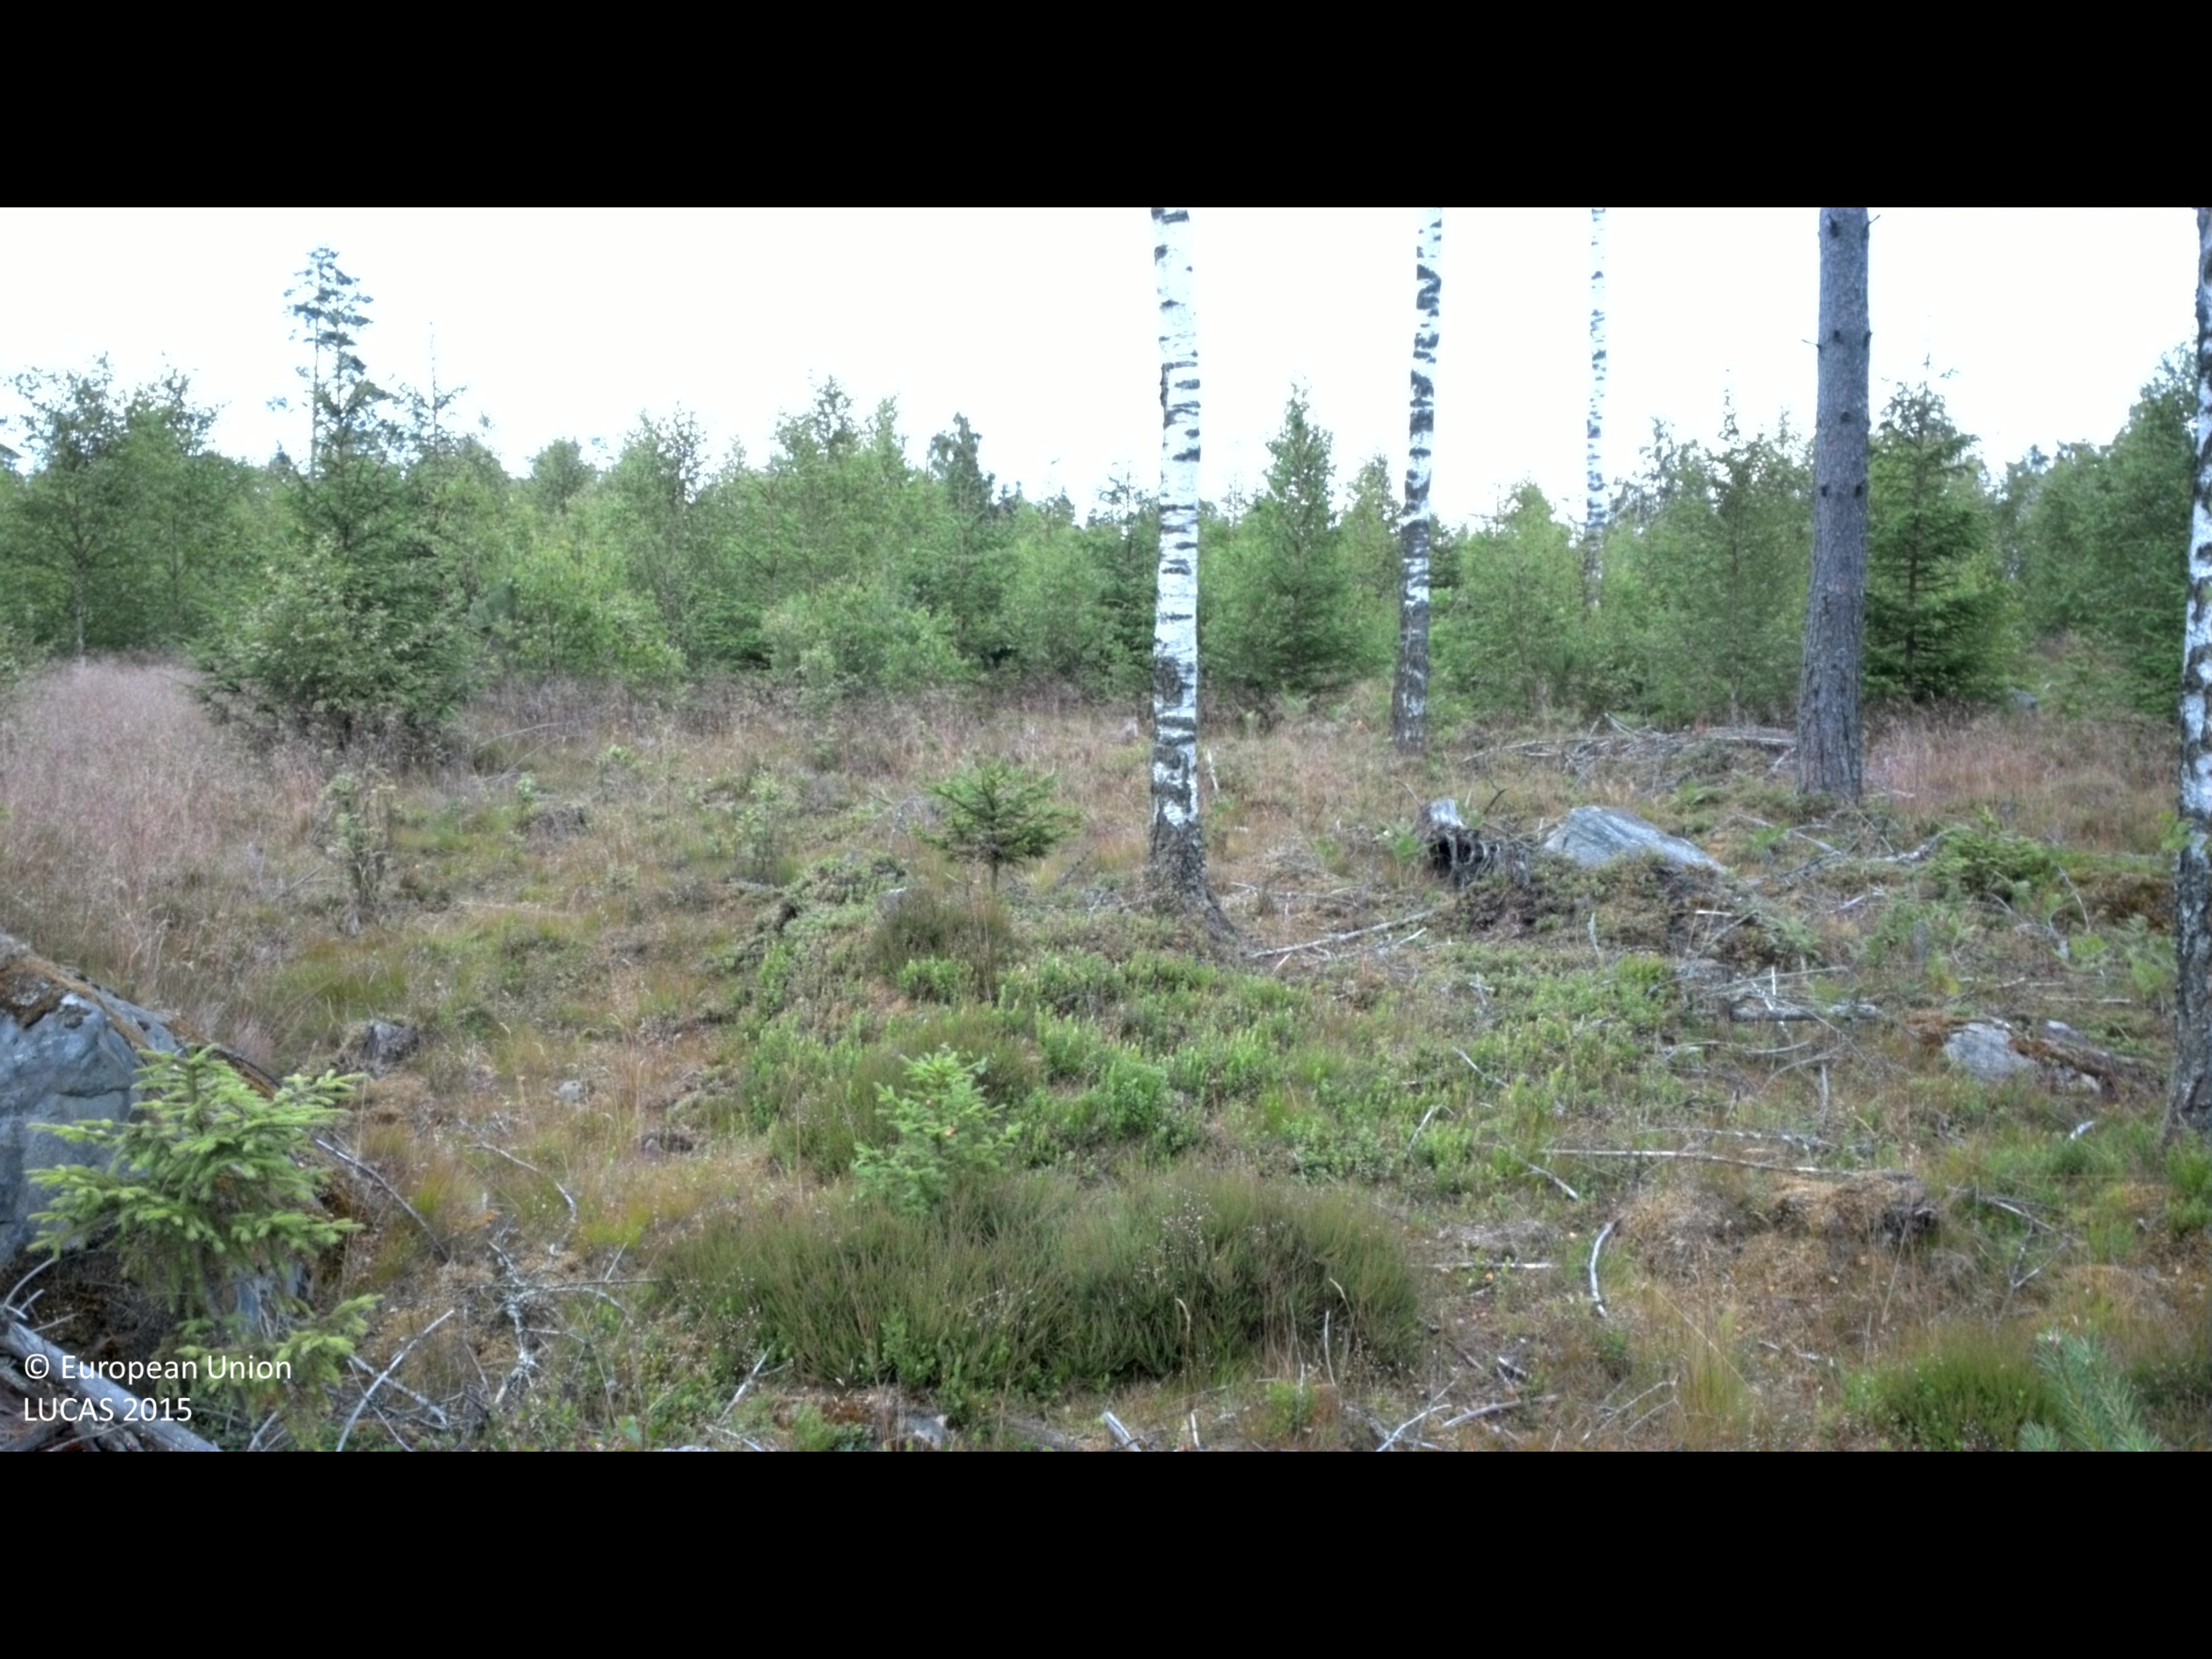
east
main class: Woodland
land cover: Broadleaved woodland
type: boreal forest
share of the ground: 25 - 50 %
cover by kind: broadleaved forest trees 40 %, shrubs 30 %, coniferous forest trees 10 %, herbaceous plants 10 %, lichens and mosses 10 %
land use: Forestry
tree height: > 5 m
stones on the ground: > 50 %
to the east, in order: Broadleaved woodland; Tracks; Broadleaved woodland; Pine dominated coniferous woodland; Spruce dominated coniferous woodland
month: July
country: SE
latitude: 56.6721
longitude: 14.3543
